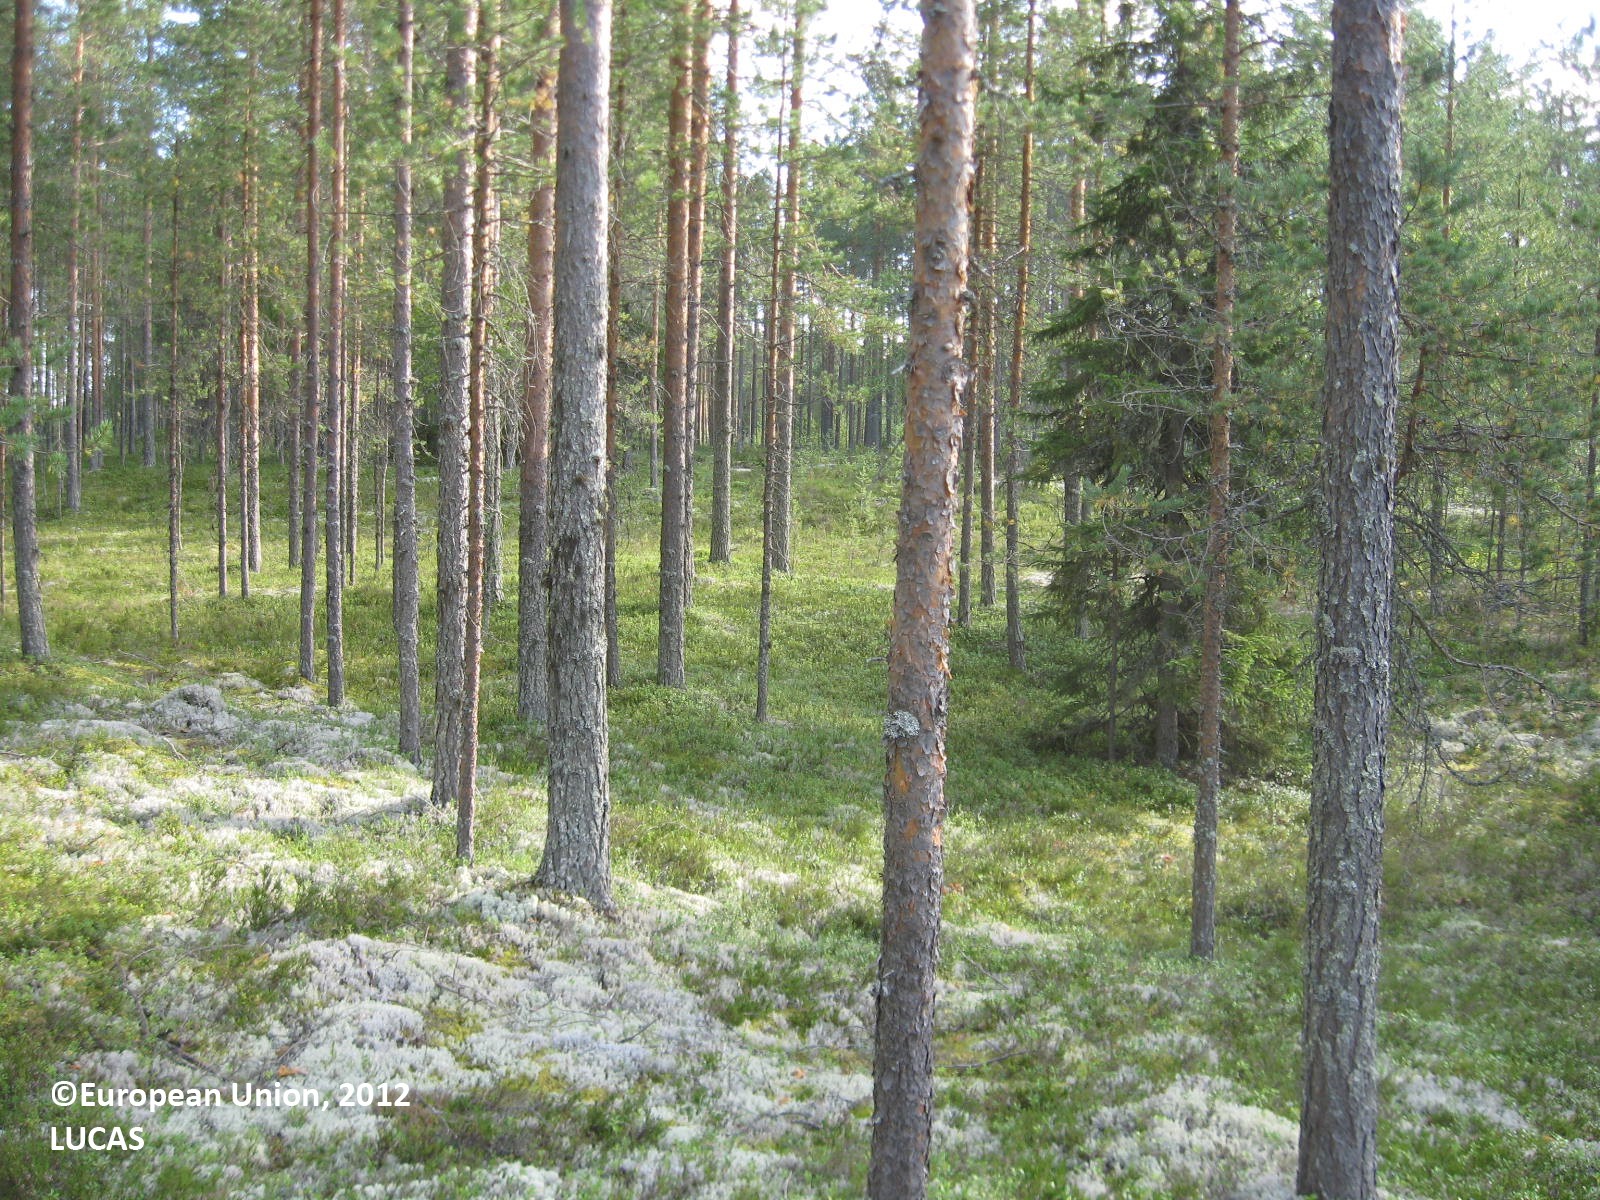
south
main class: Woodland
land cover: Pine dominated coniferous woodland
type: boreal forest
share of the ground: > 75 %
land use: Forestry
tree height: > 5 m
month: August
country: FI
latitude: 63.5988
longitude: 29.6433
